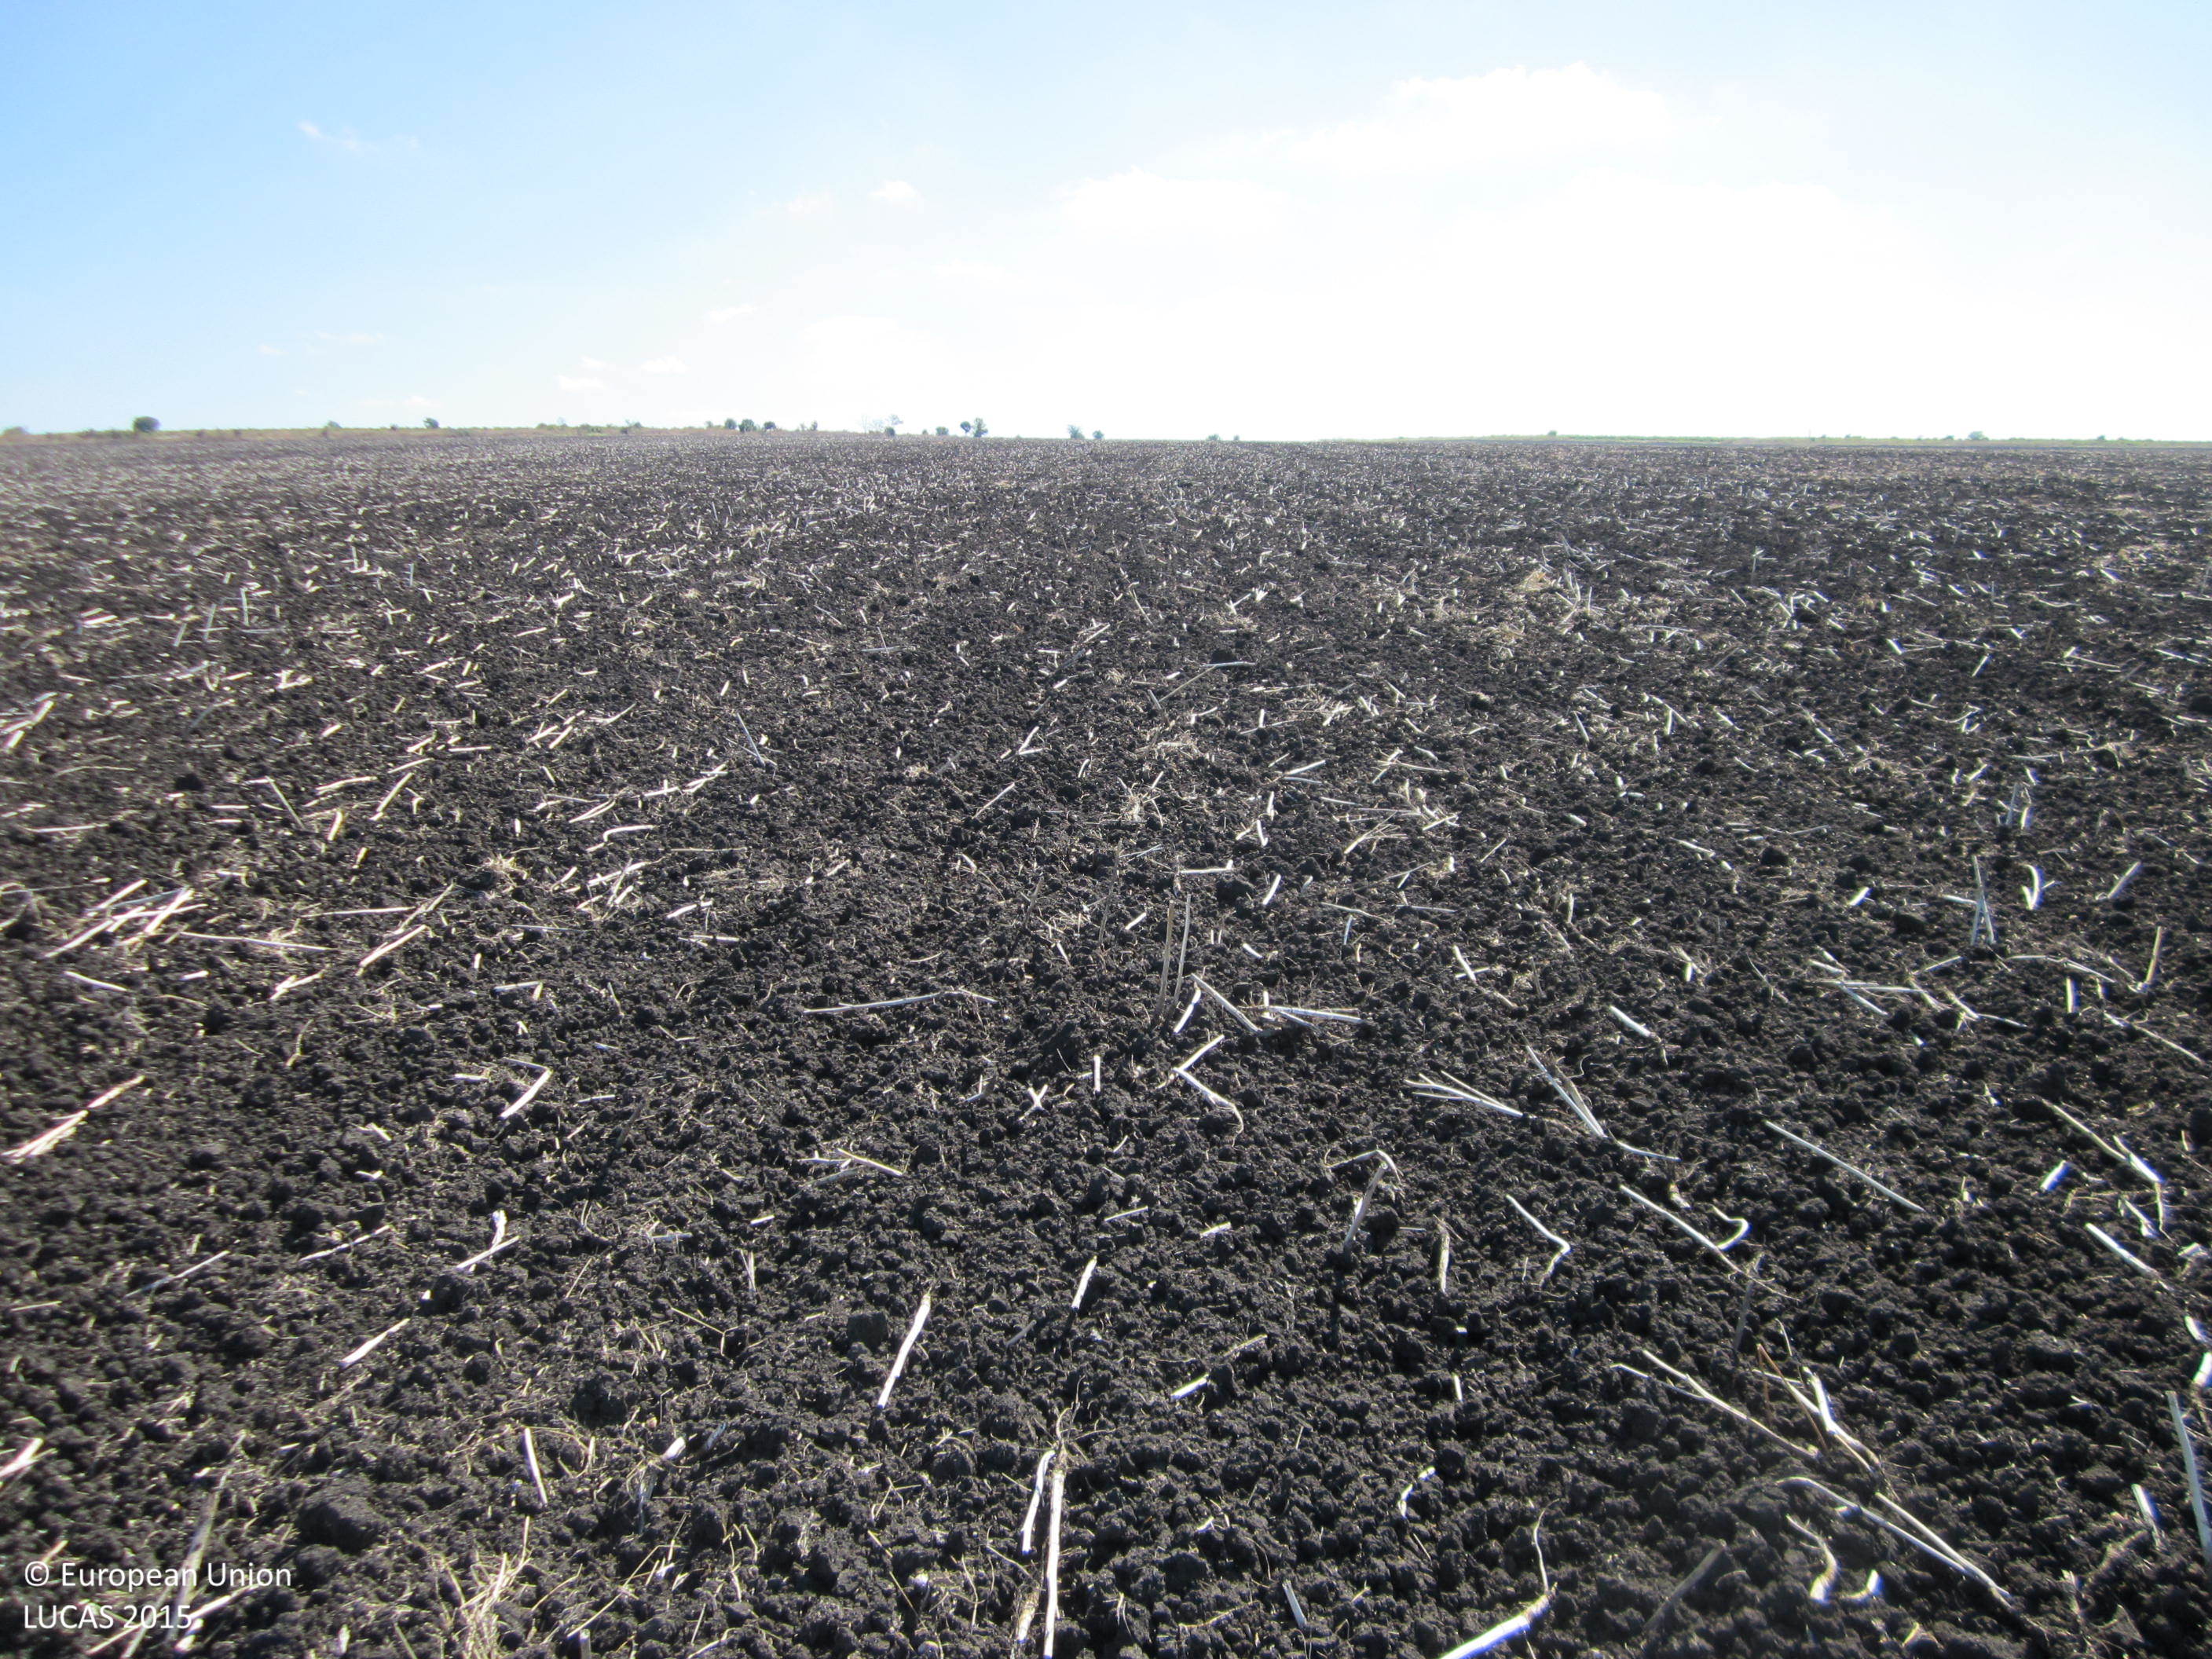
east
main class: Cropland
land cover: Sunflower
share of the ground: < 10 %
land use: Agriculture (excluding fallow land and kitchen gardens)
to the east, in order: Sunflower
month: September
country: BG
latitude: 42.5786
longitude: 27.2549
